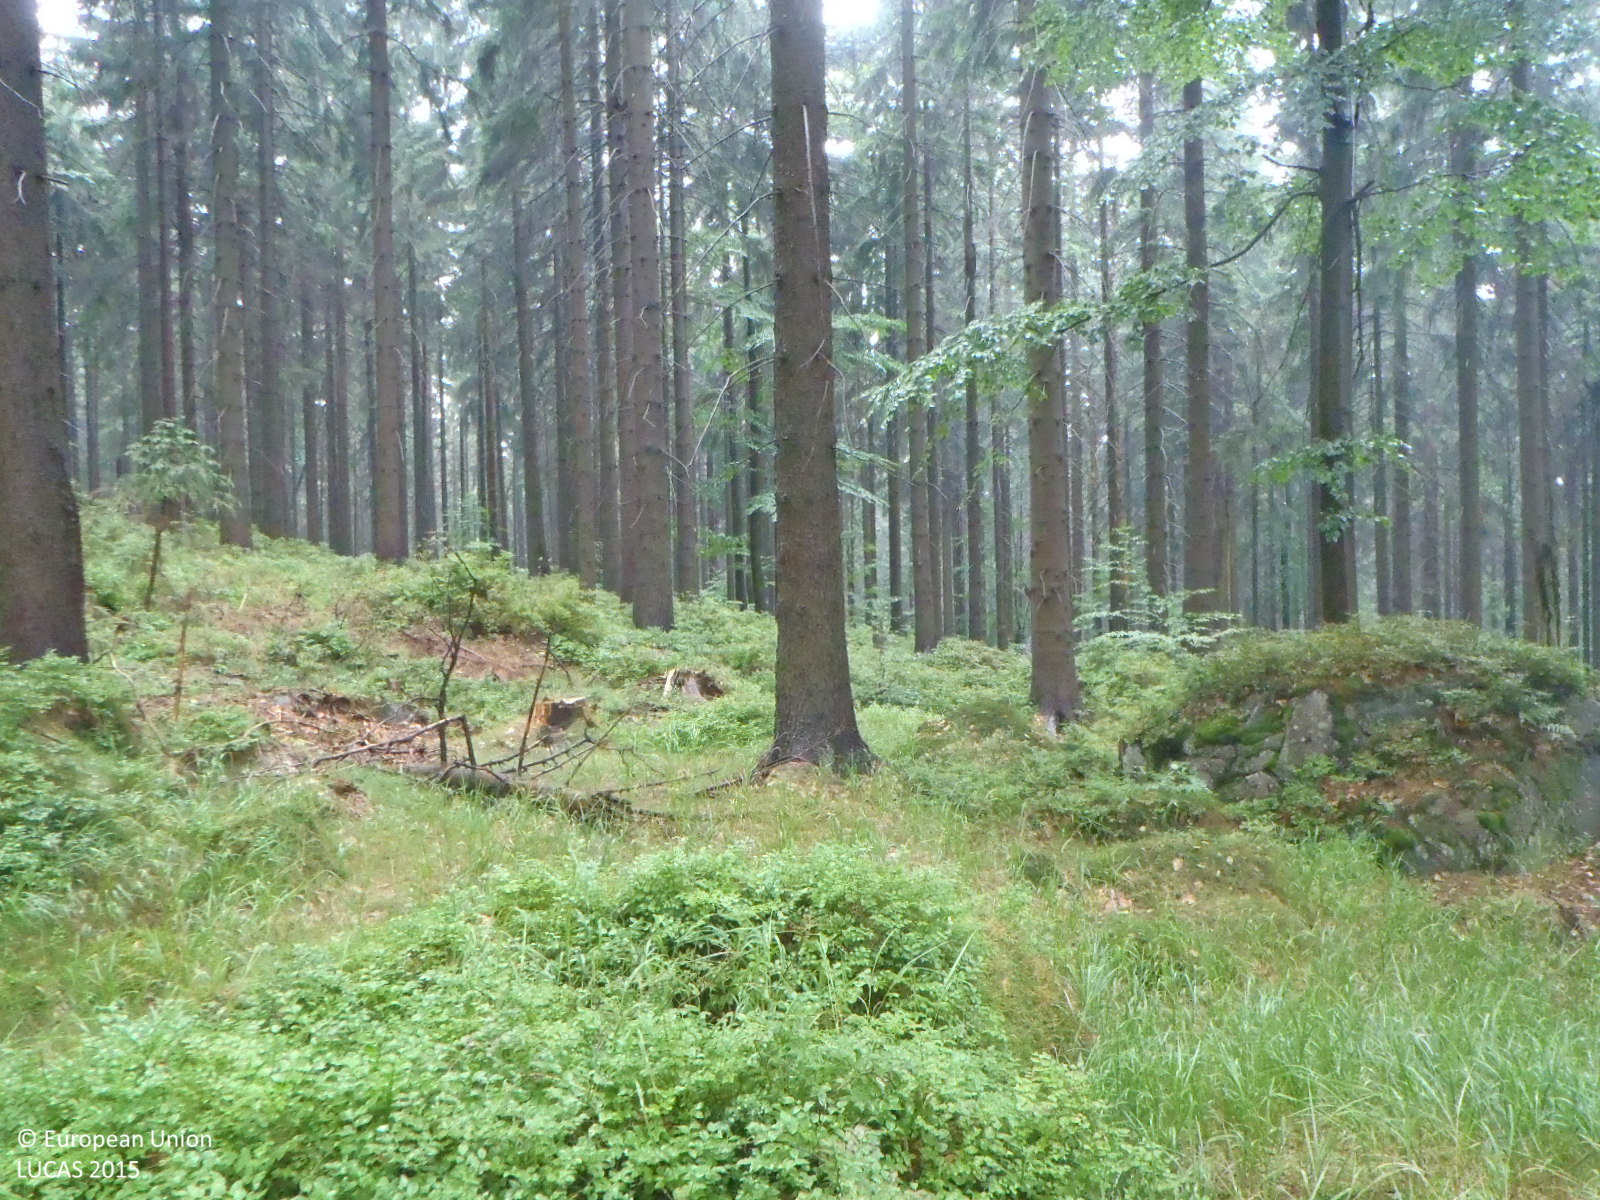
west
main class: Woodland
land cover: Spruce dominated coniferous woodland
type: hemiboreal forest and nemoral coniferous forest and mixed broadleaved-coniferous forest
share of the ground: > 75 %
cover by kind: coniferous forest trees 90 %, broadleaved forest trees 5 %, shrubs 5 %
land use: Forestry
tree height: > 5 m
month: August
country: CZ
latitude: 50.7834
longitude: 15.2657
